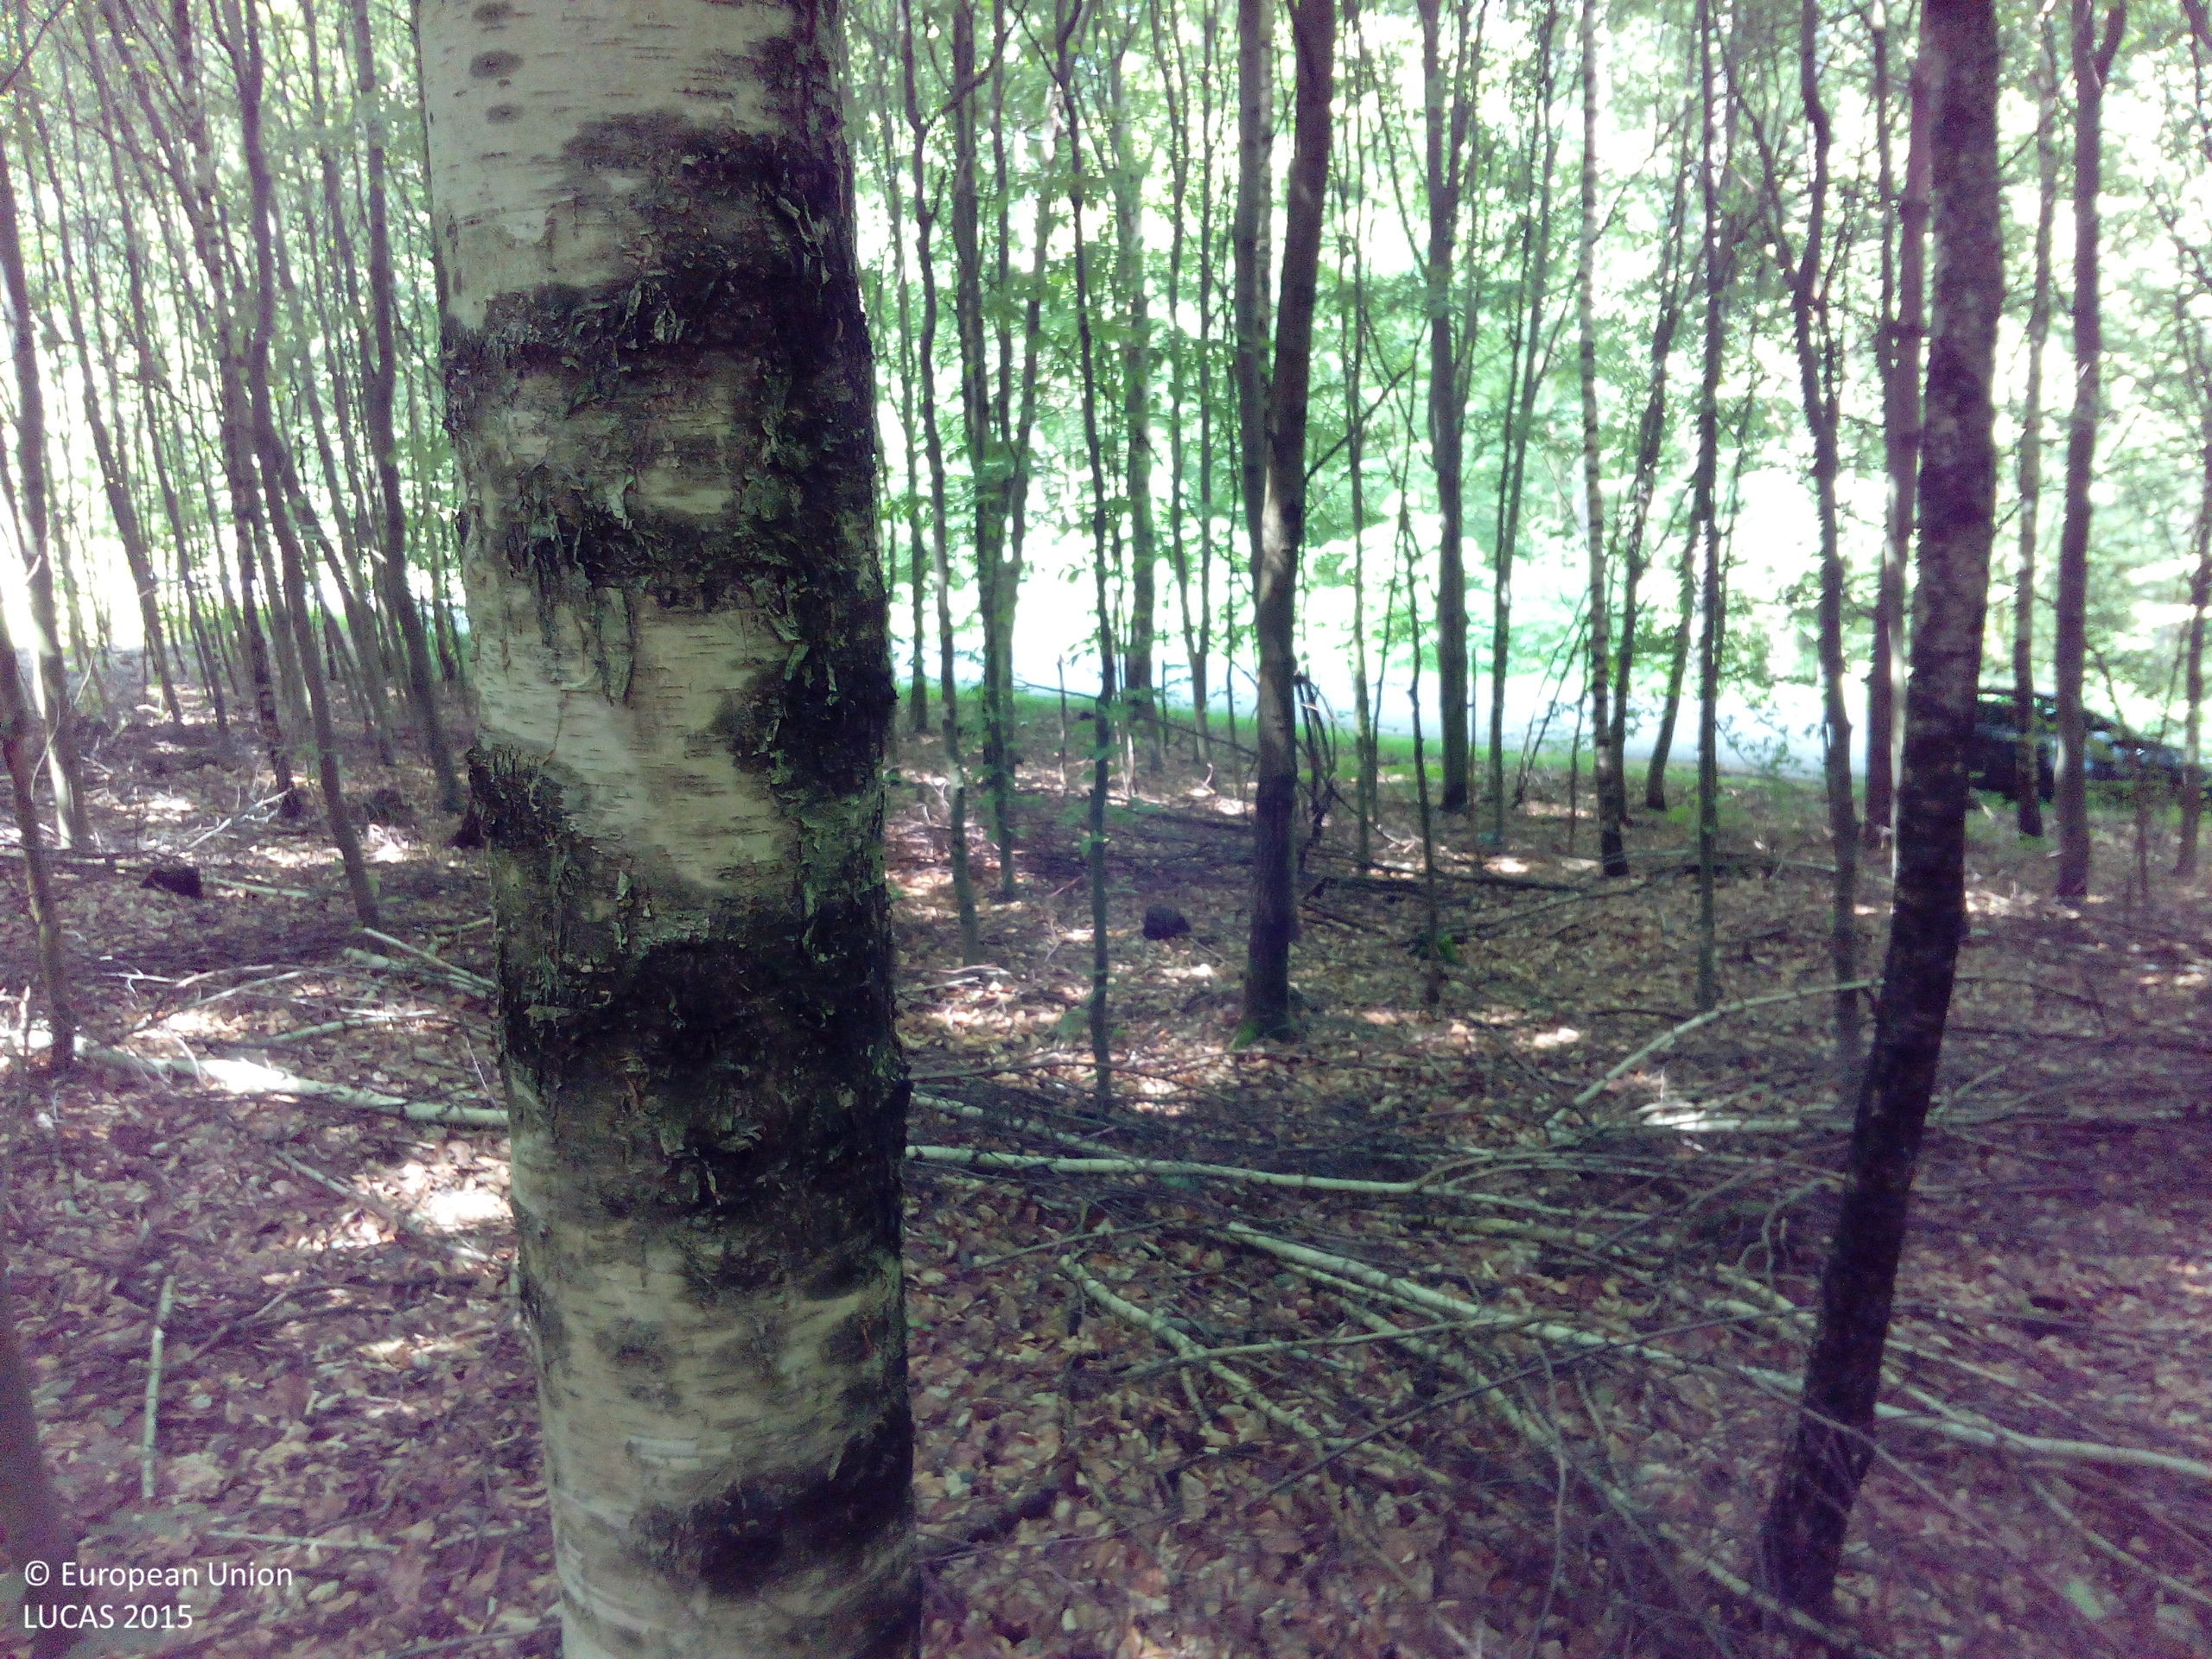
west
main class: Woodland
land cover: Broadleaved woodland
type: beech forest
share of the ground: > 75 %
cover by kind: broadleaved forest trees 90 %, coniferous forest trees 5 %, unconsolidated bare surface 5 %
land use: Forestry
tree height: > 5 m
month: June
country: DE
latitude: 51.0329
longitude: 13.9795
